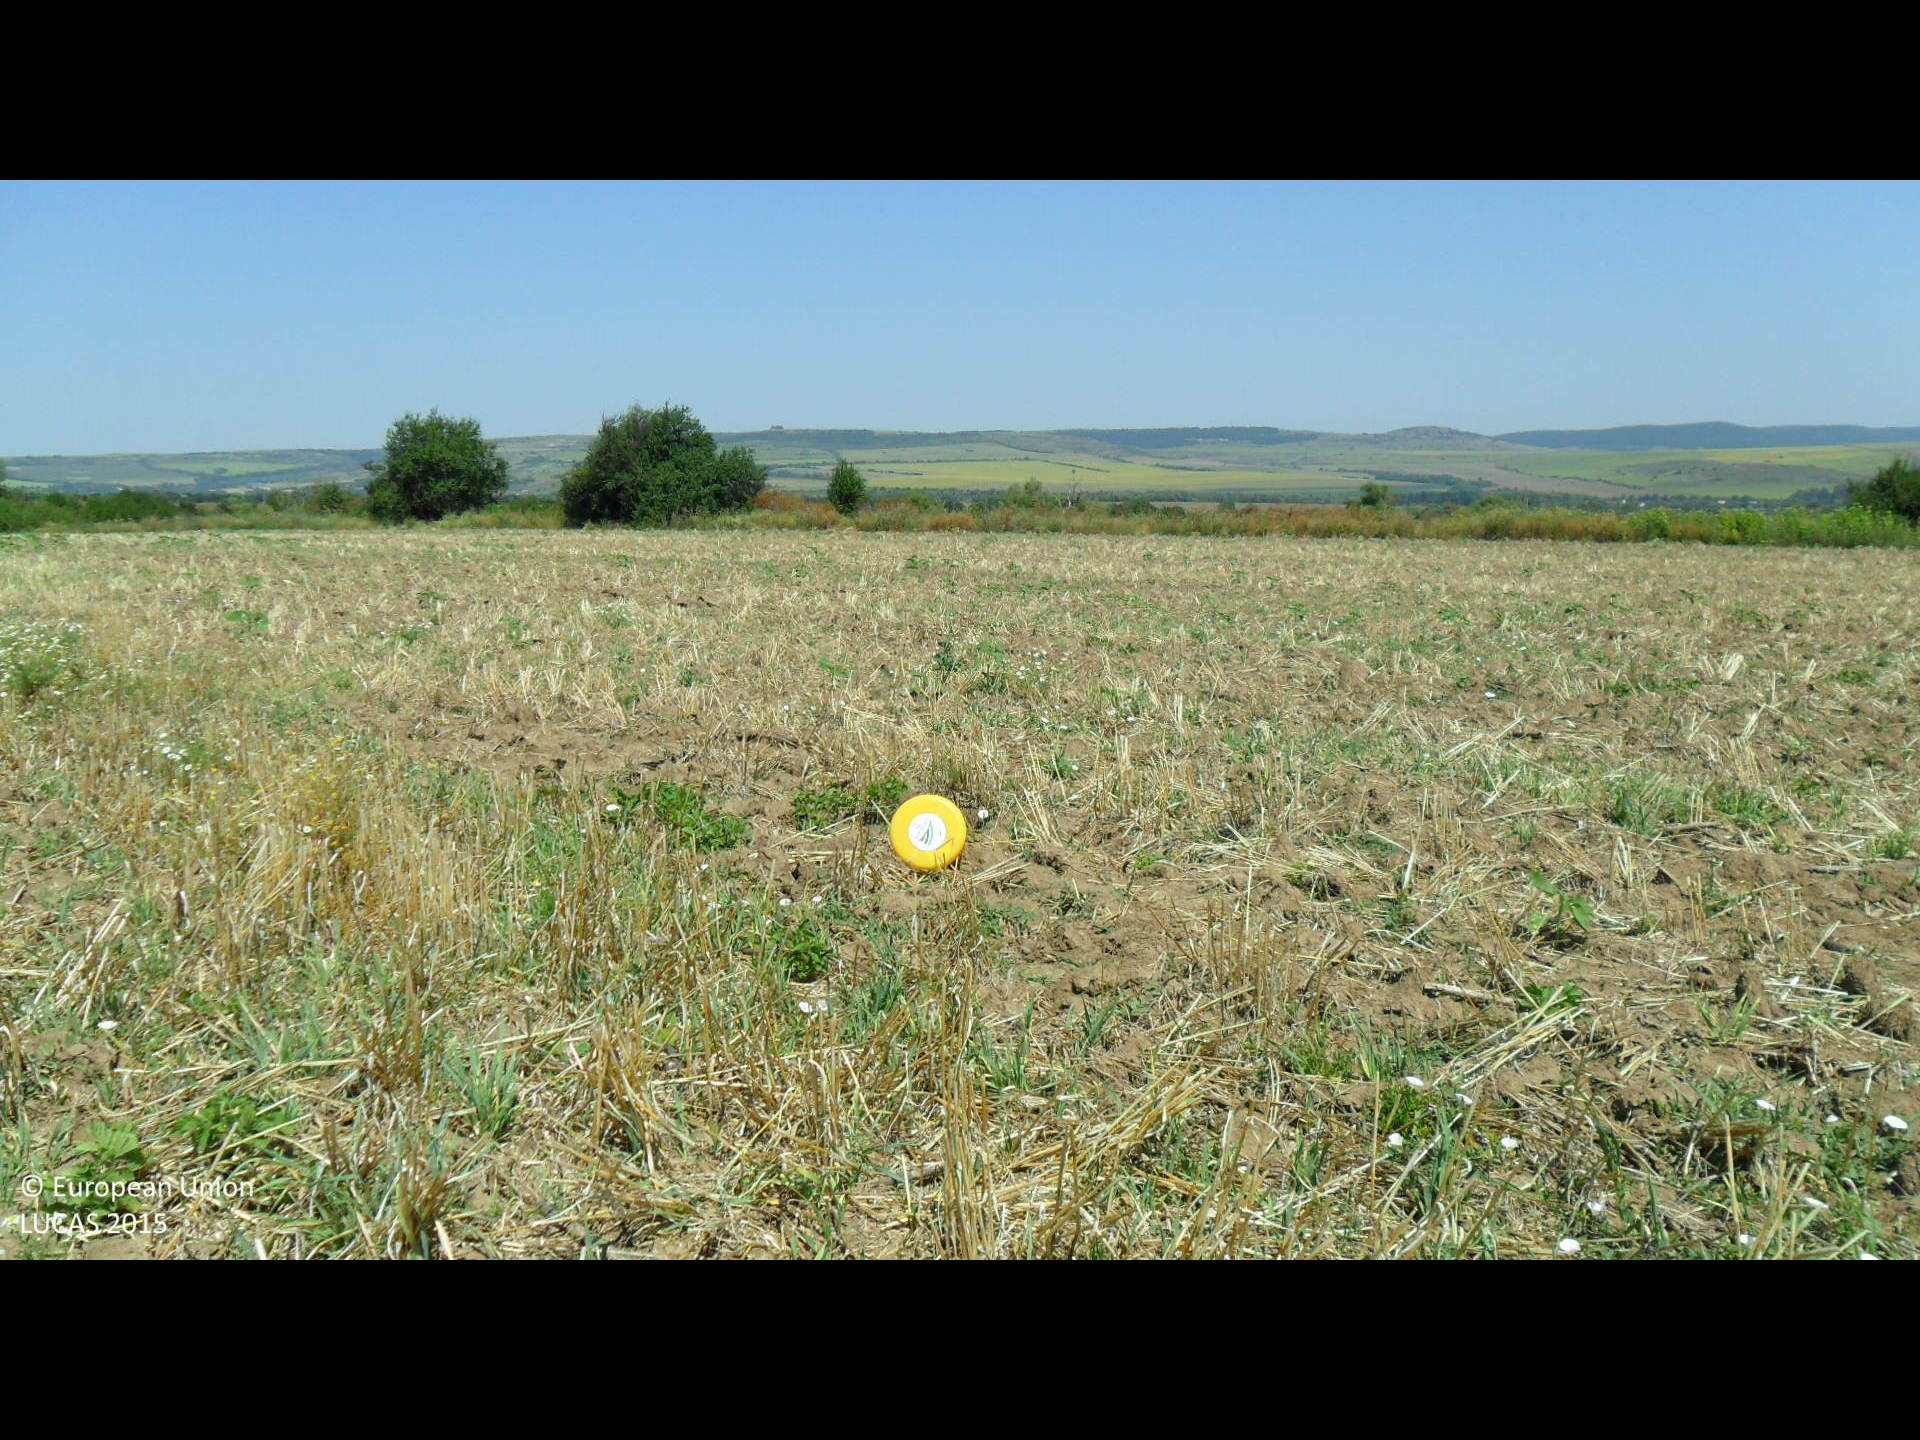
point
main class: Cropland
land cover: Barley
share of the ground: 10 - 25 %
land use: Agriculture (excluding fallow land and kitchen gardens)
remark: Harvested field
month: August
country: BG
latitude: 43.3341
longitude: 26.1403
